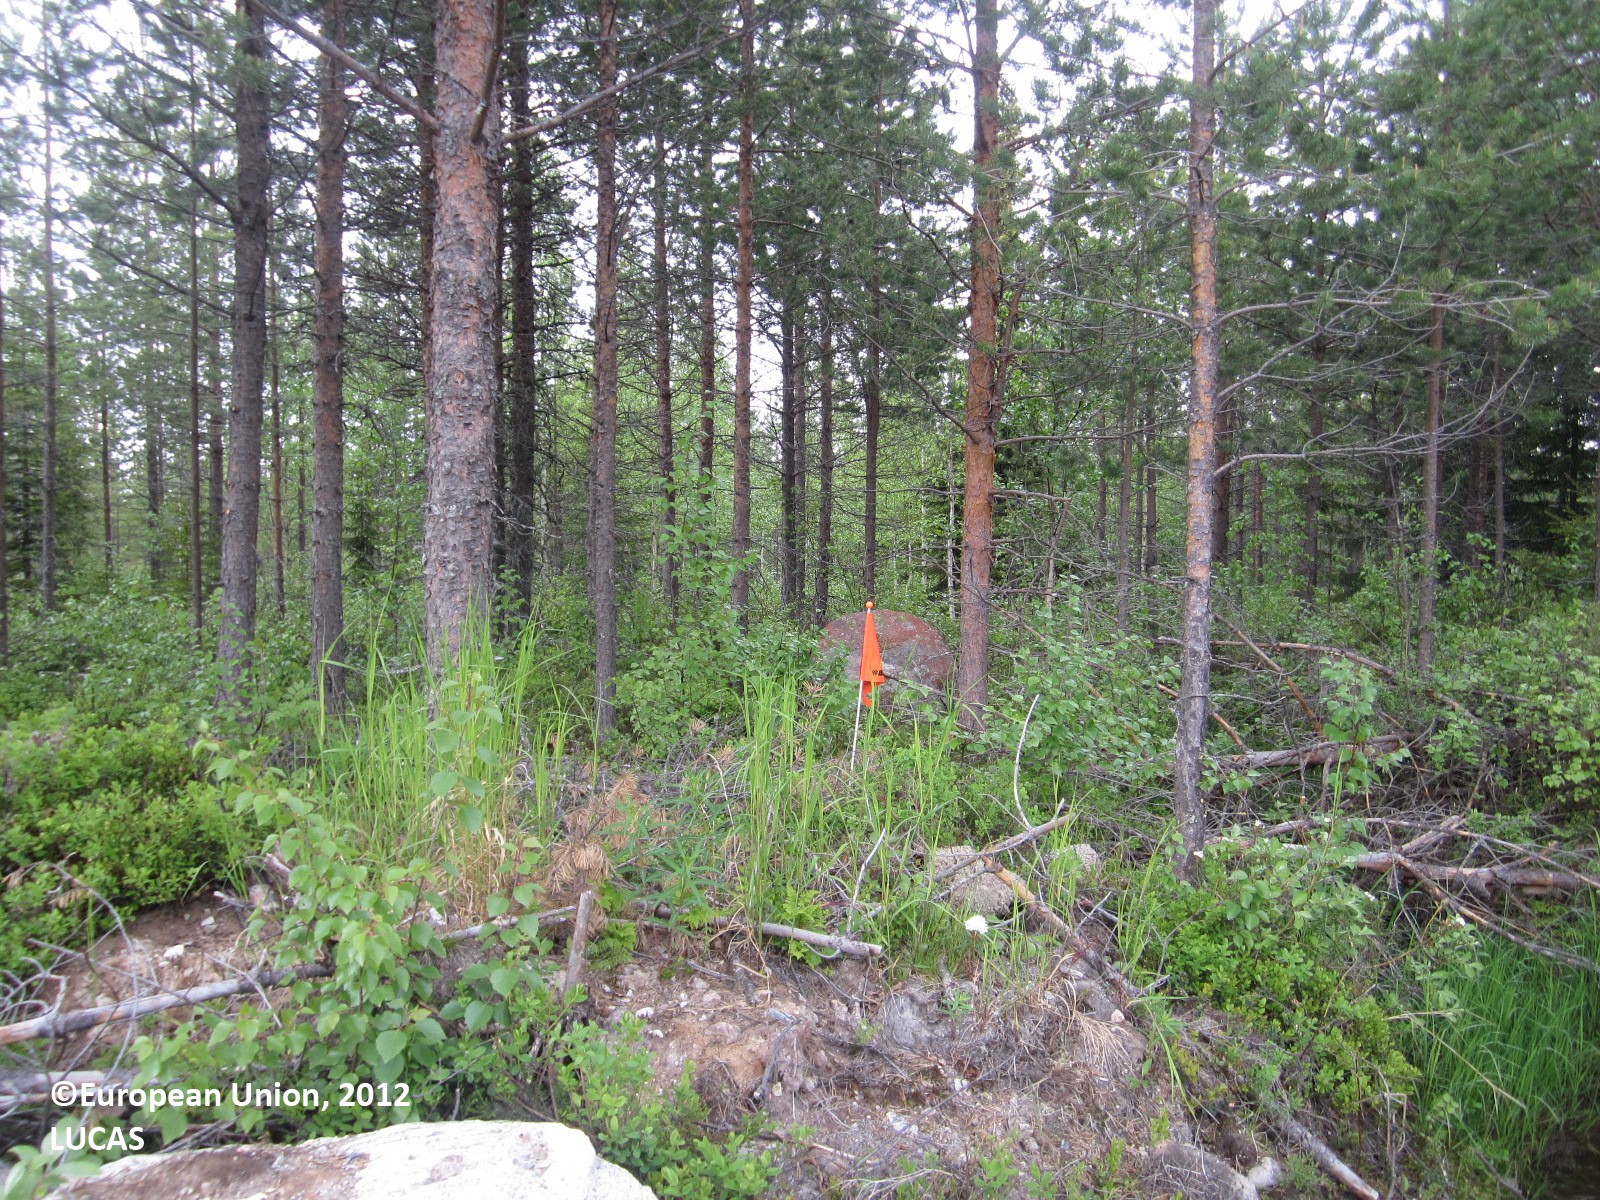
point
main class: Woodland
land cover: Pine dominated mixed woodland
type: boreal forest
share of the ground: > 75 %
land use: Forestry
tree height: > 5 m
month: June
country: FI
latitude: 65.0247
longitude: 29.1912
